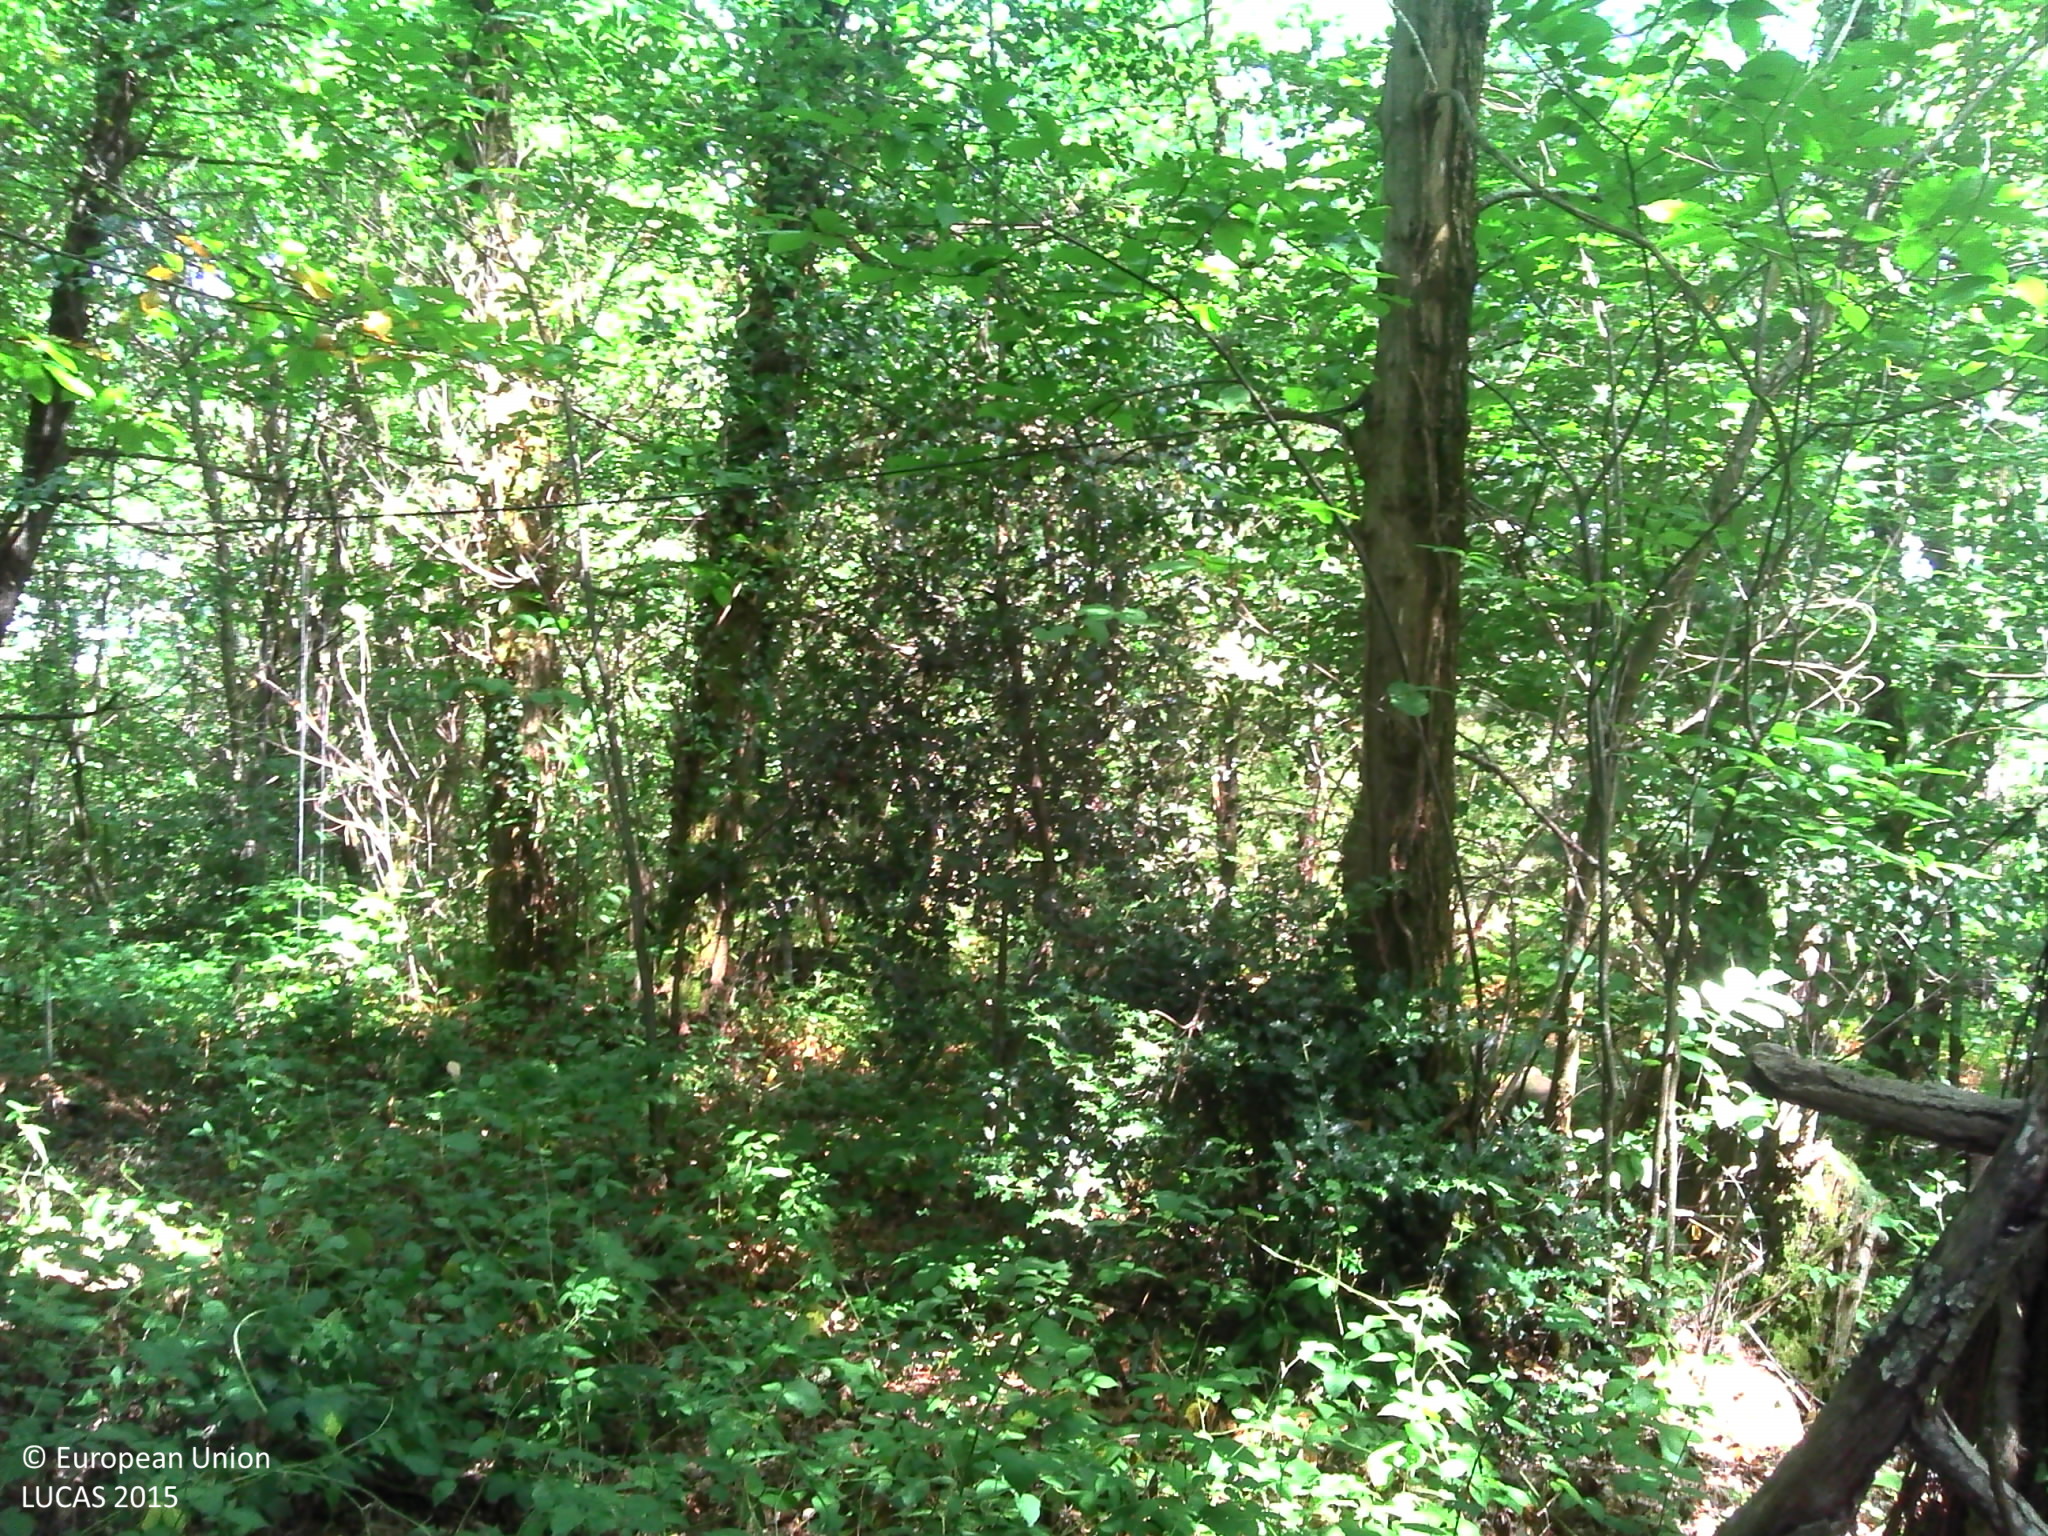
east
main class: Woodland
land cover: Broadleaved woodland
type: mesophytic deciduous forest
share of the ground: > 75 %
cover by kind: broadleaved forest trees 70 %, herbaceous plants 15 %, shrubs 10 %
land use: Forestry
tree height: > 5 m
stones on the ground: < 10 %
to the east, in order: Broadleaved woodland; Grassland without tree/shrub cover; Tracks; Broadleaved woodland; Tracks; Fences; Broadleaved woodland
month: August
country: FR
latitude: 45.2072
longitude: 0.7597
